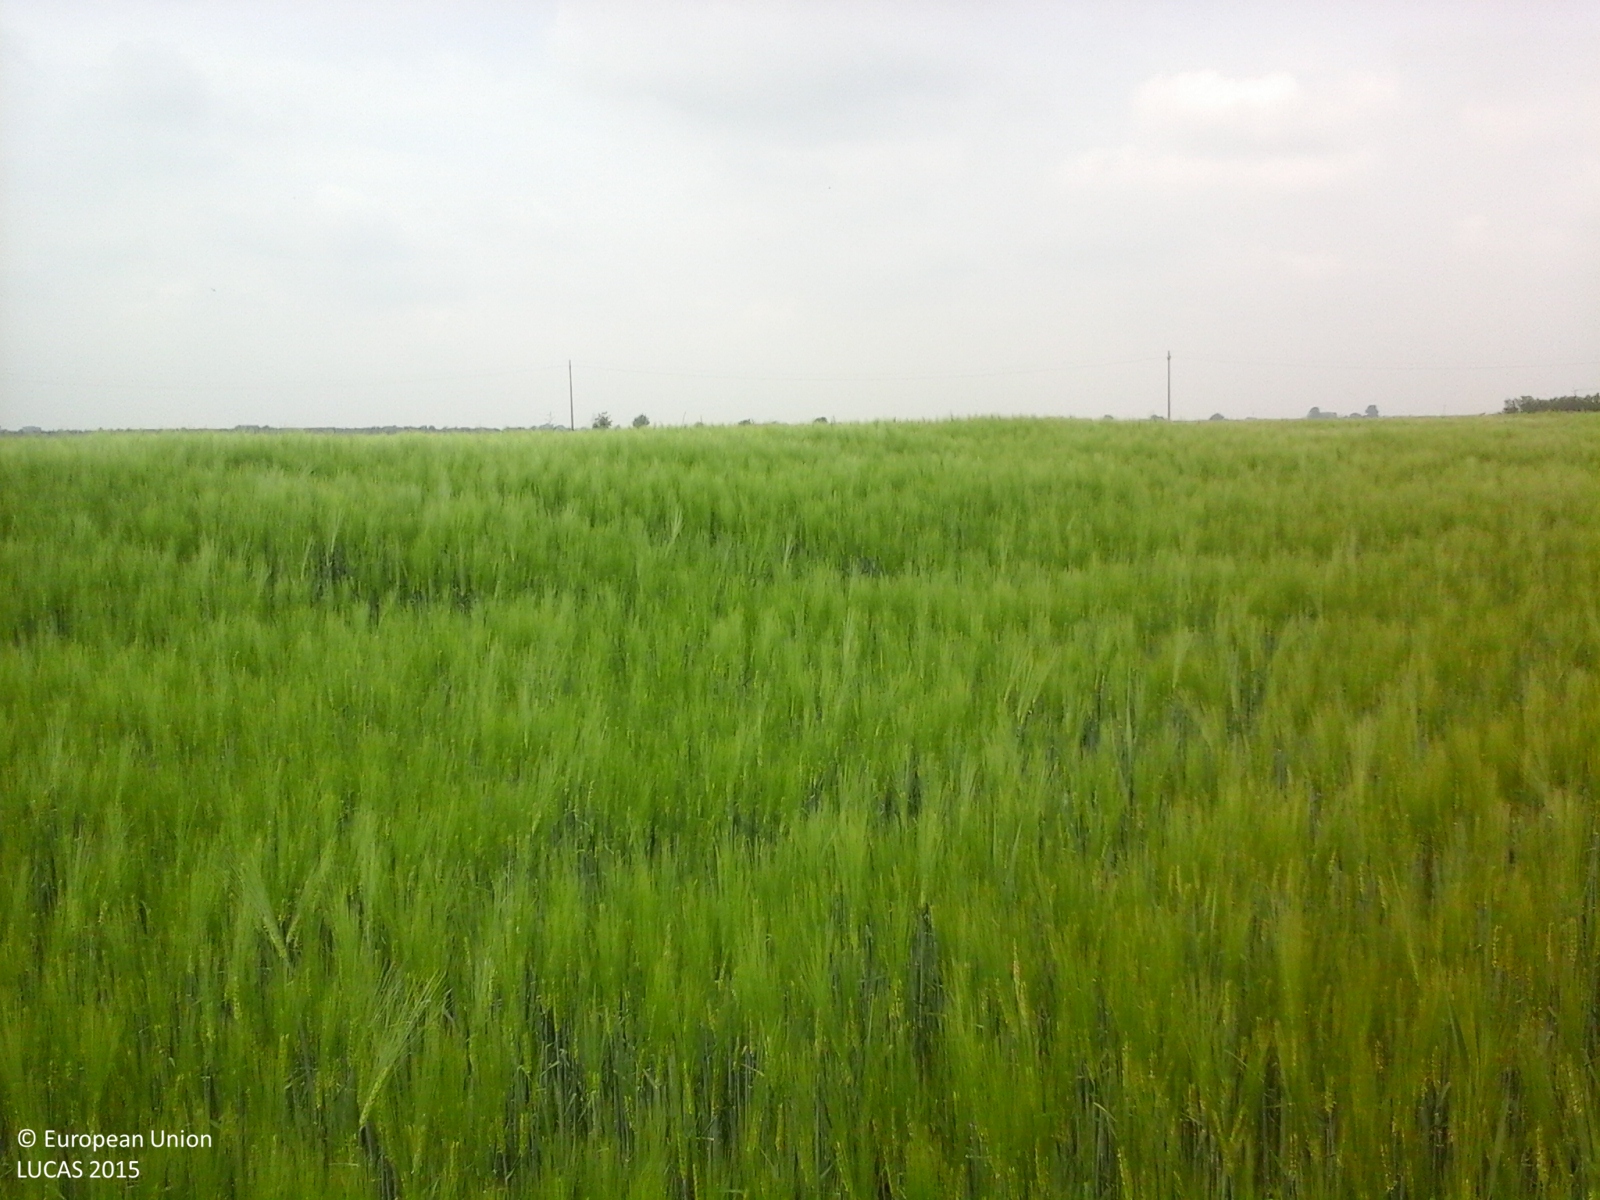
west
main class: Cropland
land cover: Durum wheat
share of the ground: > 75 %
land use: Agriculture (excluding fallow land and kitchen gardens)
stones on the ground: < 10 %
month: May
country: IT
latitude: 44.9024
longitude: 11.2260
